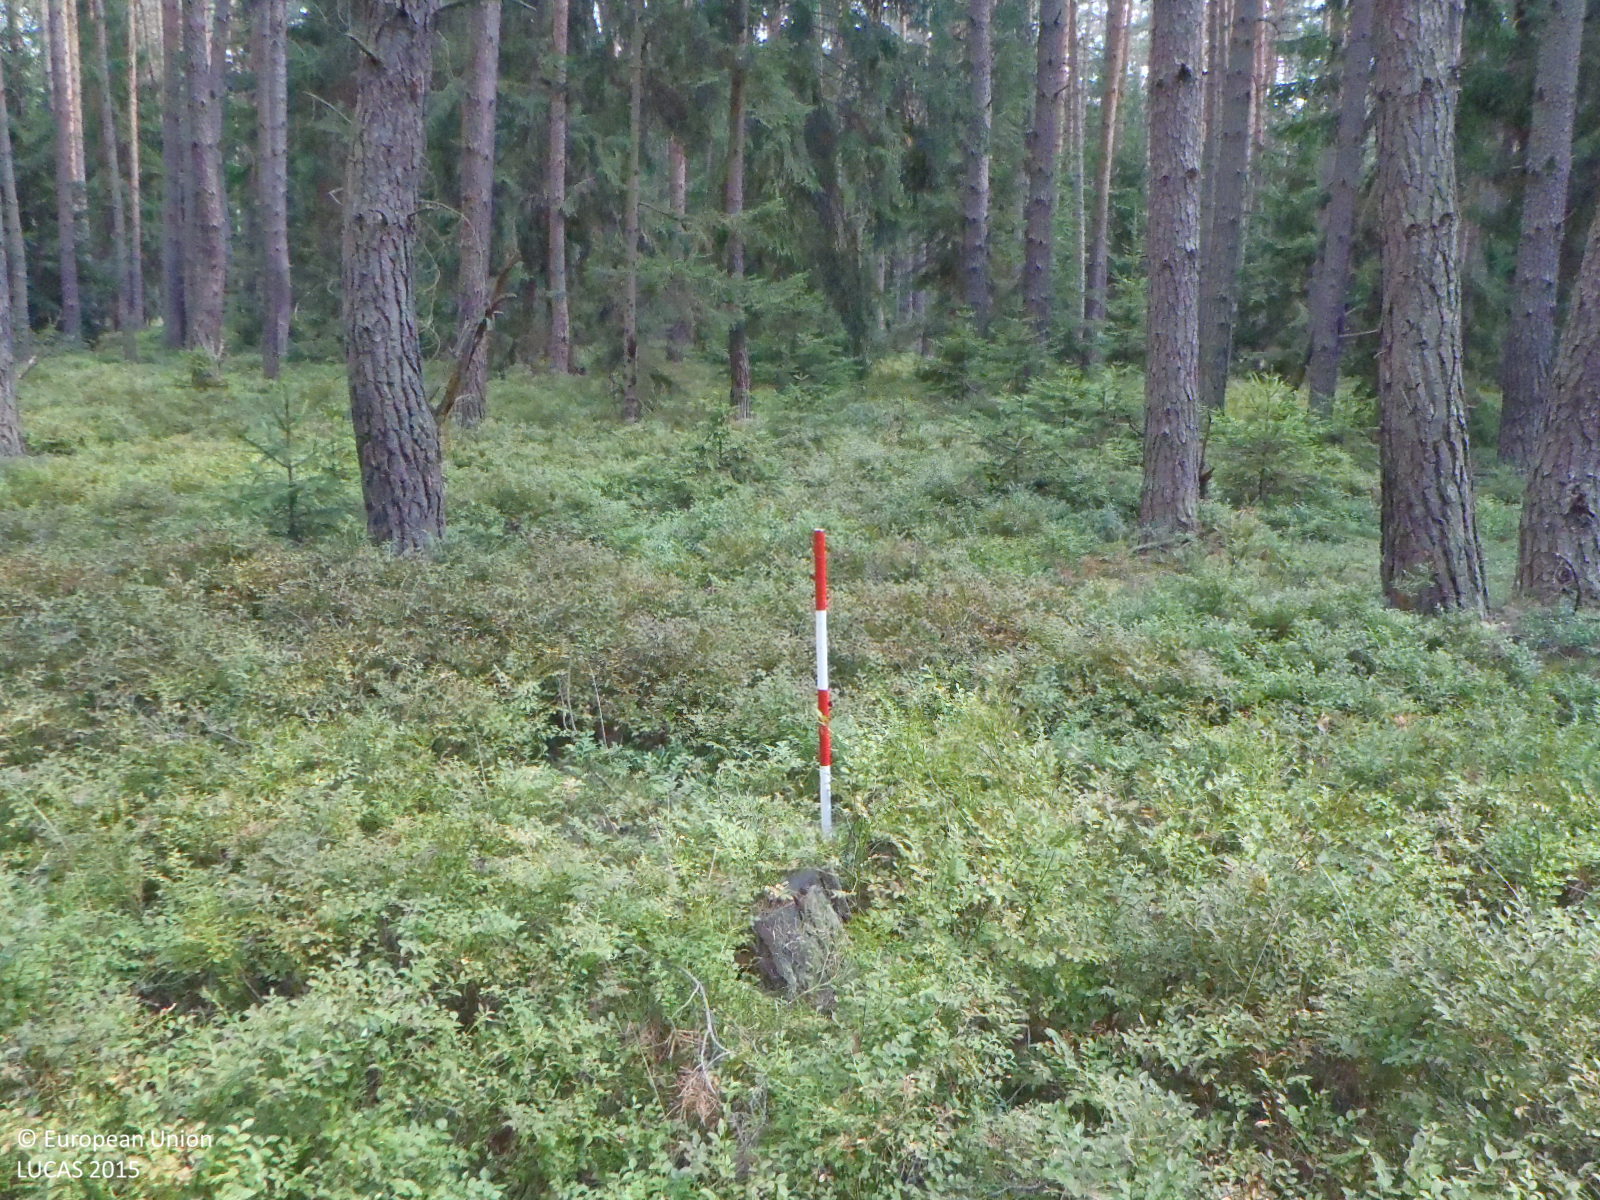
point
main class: Woodland
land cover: Pine dominated coniferous woodland
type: hemiboreal forest and nemoral coniferous forest and mixed broadleaved-coniferous forest
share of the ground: > 75 %
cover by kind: coniferous forest trees 95 %, shrubs 5 %
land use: Forestry
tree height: > 5 m
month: August
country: CZ
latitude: 50.5903
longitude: 14.7343
